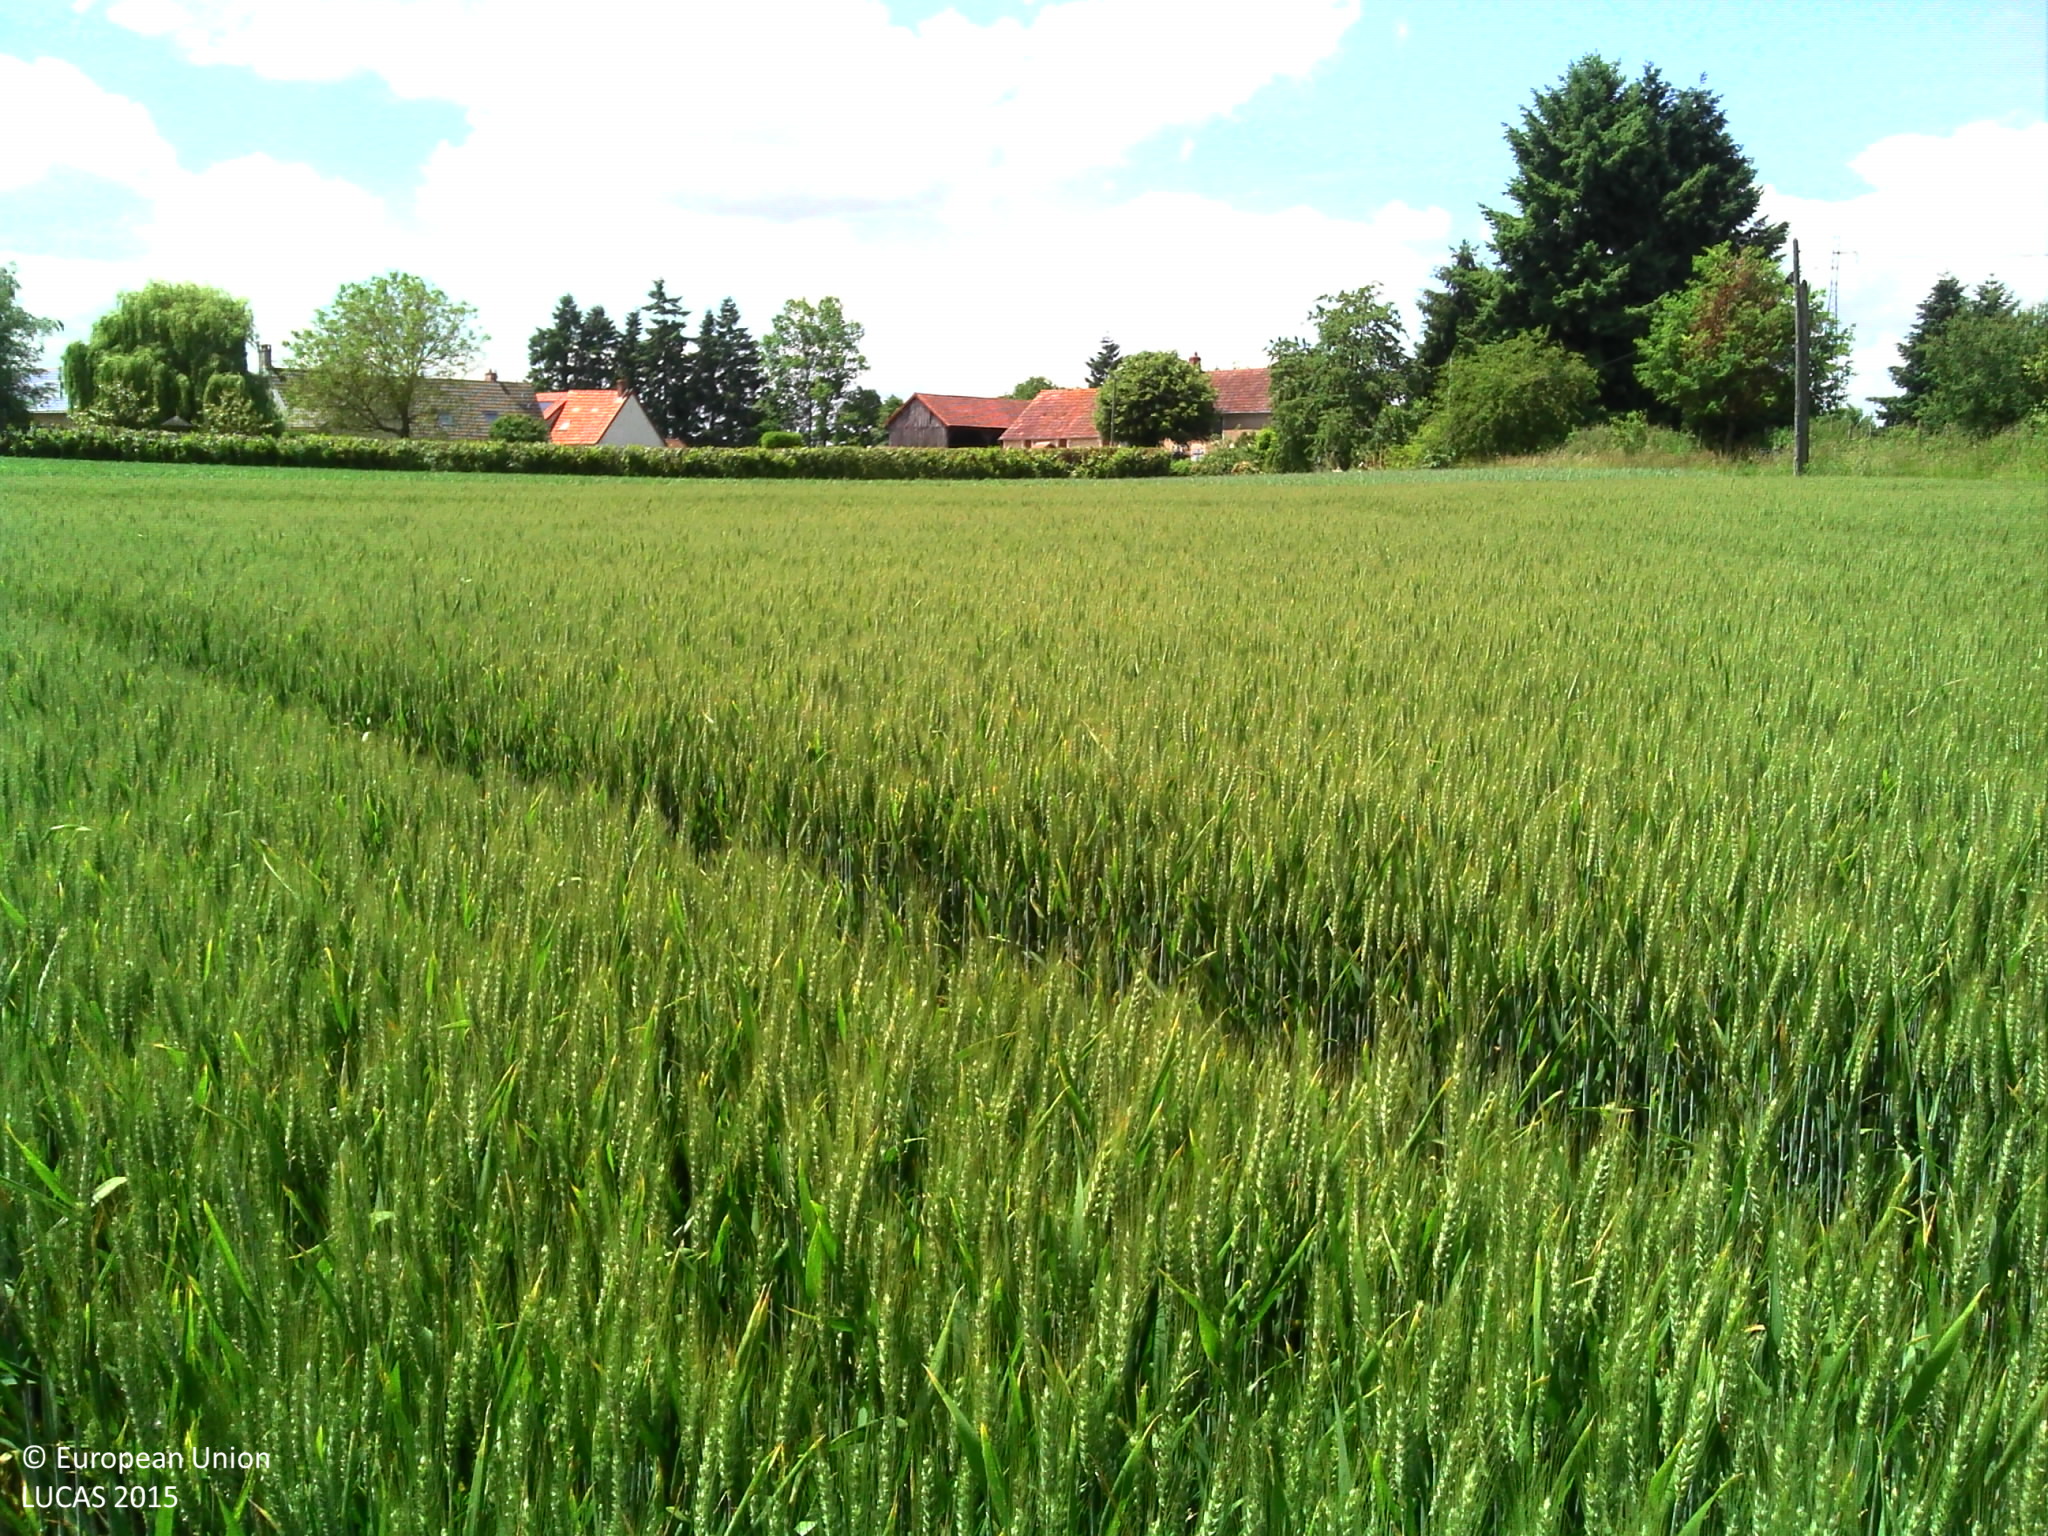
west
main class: Cropland
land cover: Common wheat
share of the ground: > 75 %
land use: Agriculture (excluding fallow land and kitchen gardens)
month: May
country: FR
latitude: 47.2017
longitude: 2.9324
